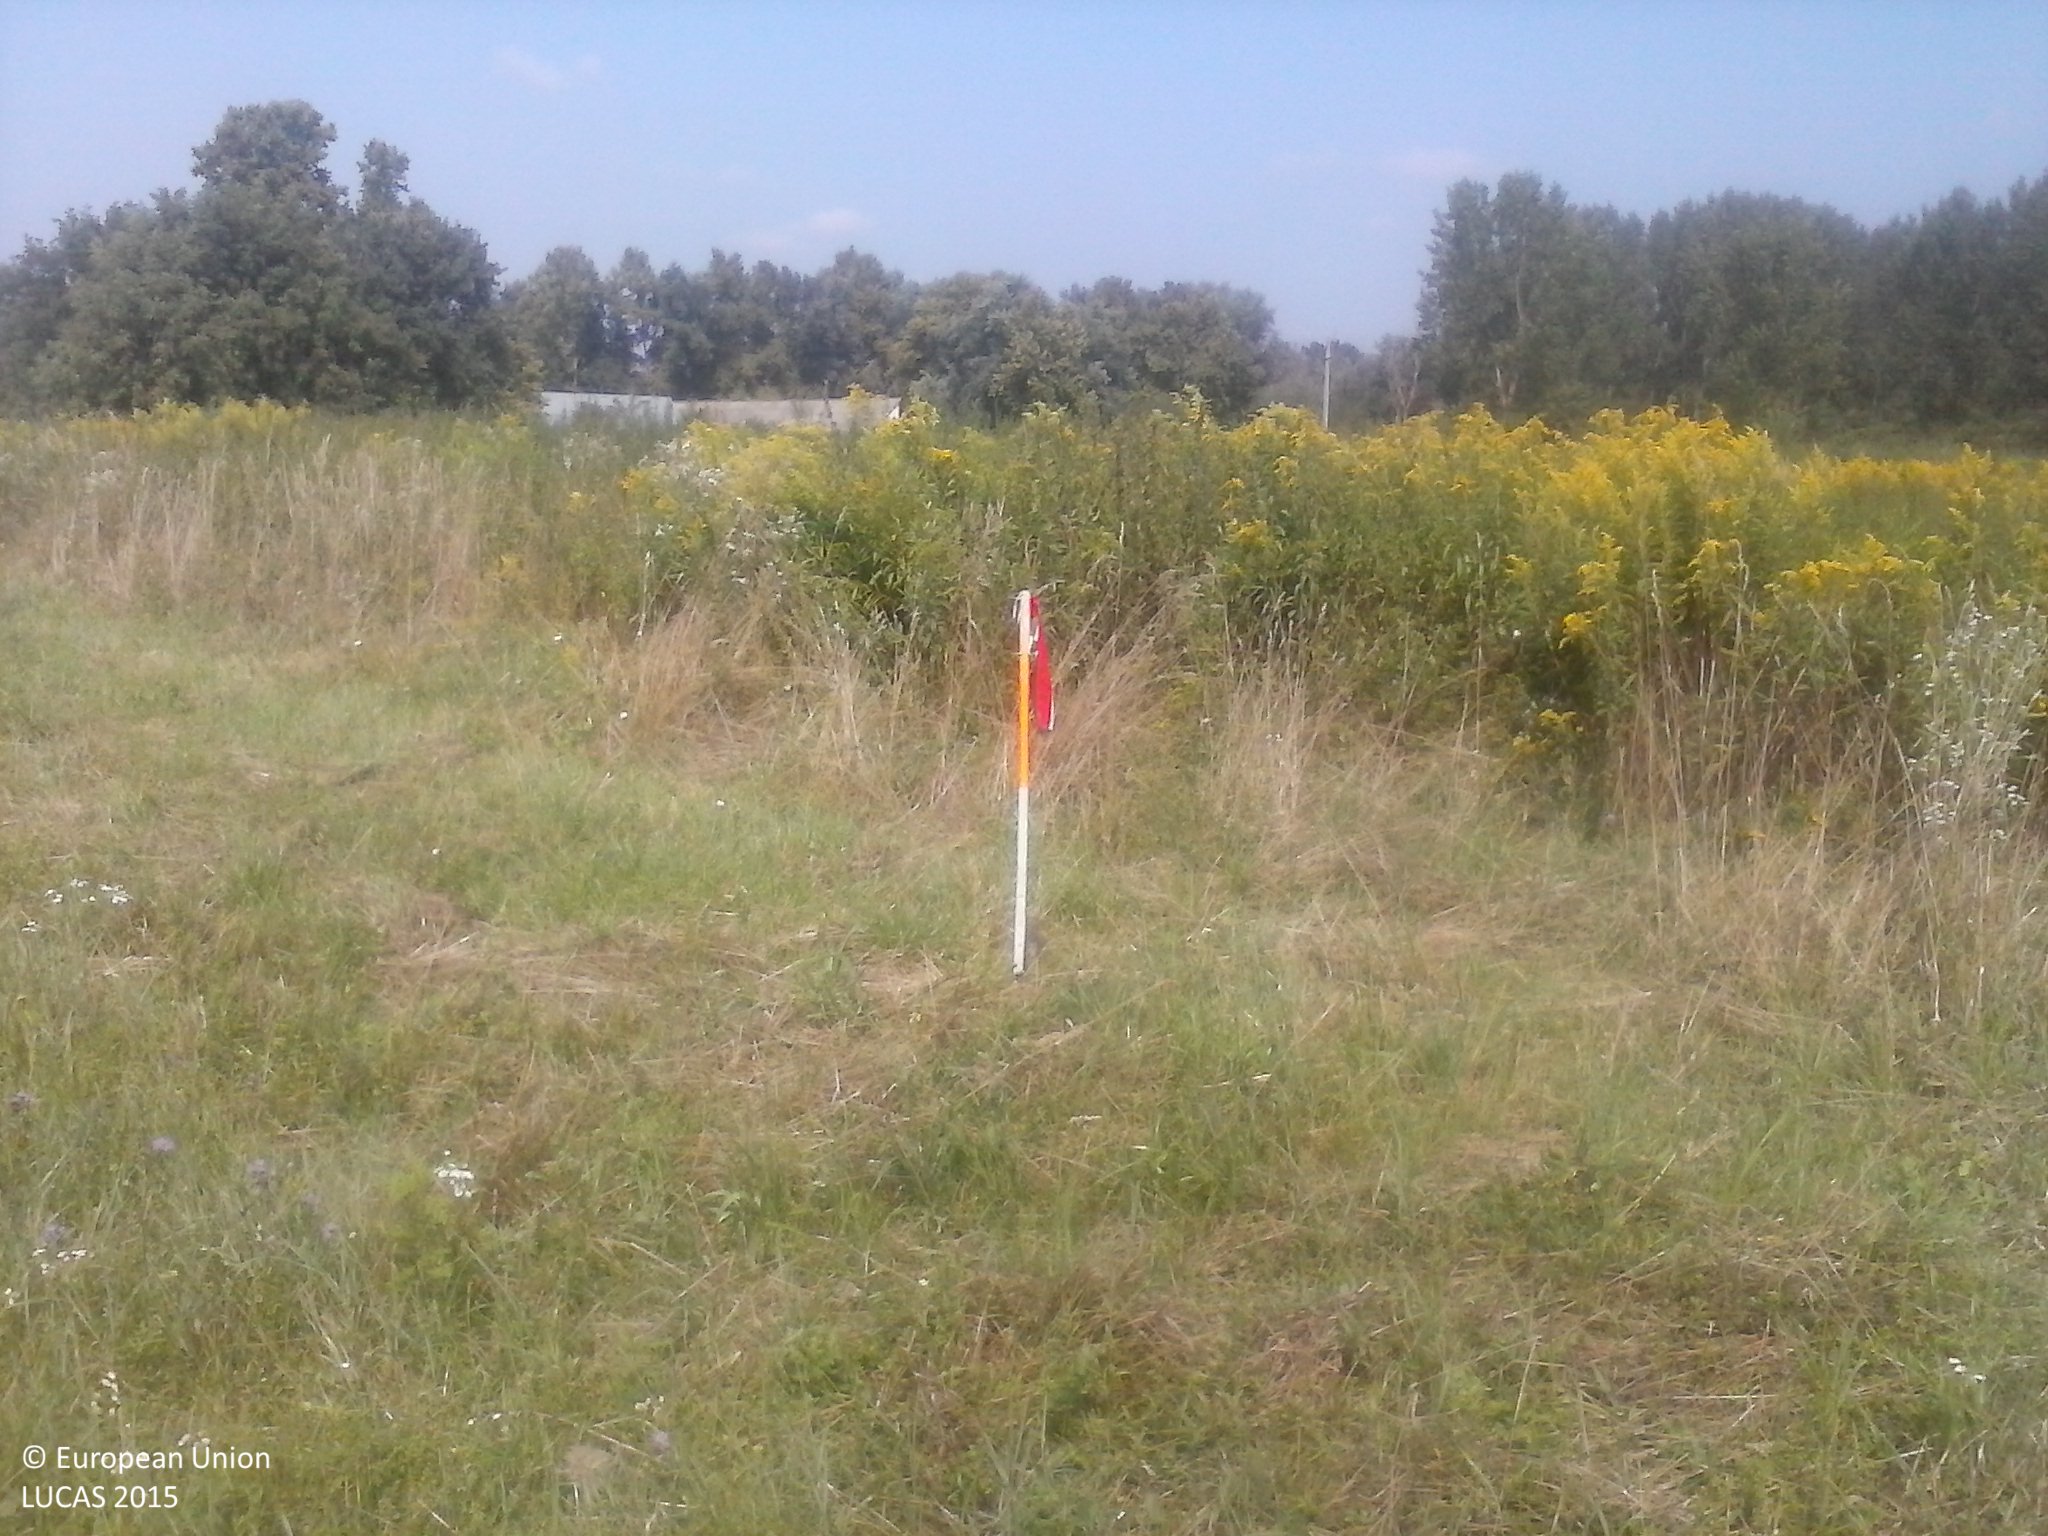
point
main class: Grassland
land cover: Grassland without tree/shrub cover
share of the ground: > 75 %
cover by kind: herbaceous plants 100 %
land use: Agriculture (excluding fallow land and kitchen gardens)
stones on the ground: < 10 %
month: August
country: HU
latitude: 45.8870
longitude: 17.7745
